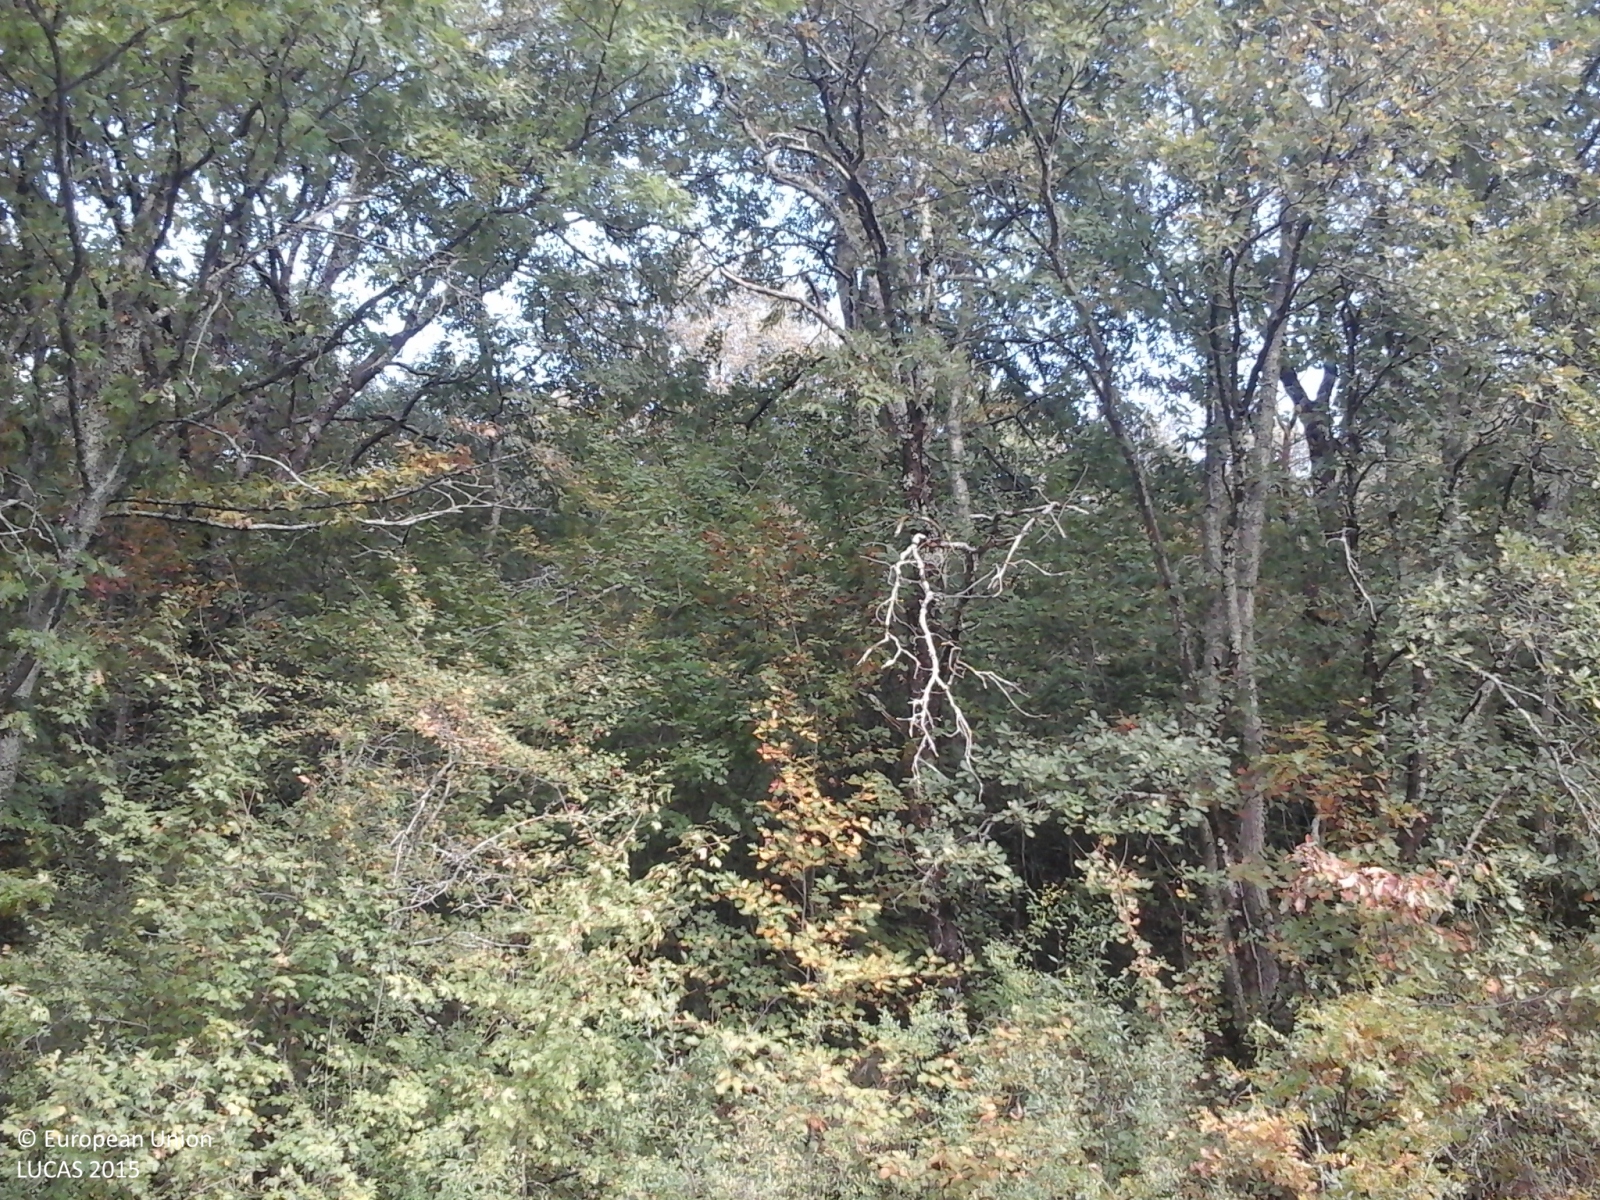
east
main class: Woodland
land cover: Broadleaved woodland
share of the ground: > 75 %
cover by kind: broadleaved forest trees 95 %, herbaceous plants 5 %
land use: Semi-natural and natural areas not in use
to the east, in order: Broadleaved woodland; Spontaneously vegetated surfaces; Shrubland without tree cover; Paved roads, cycling and walking lanes; Grass margins; Ditches and canals; Broadleaved woodland; Grassland without tree/shrub cover; Abandoned hedges; Artificial constructions in urban areas; Lines of trees; Grassland without tree/shrub cover; Broadleaved woodland
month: October
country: IT
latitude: 43.2623
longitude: 12.1989
